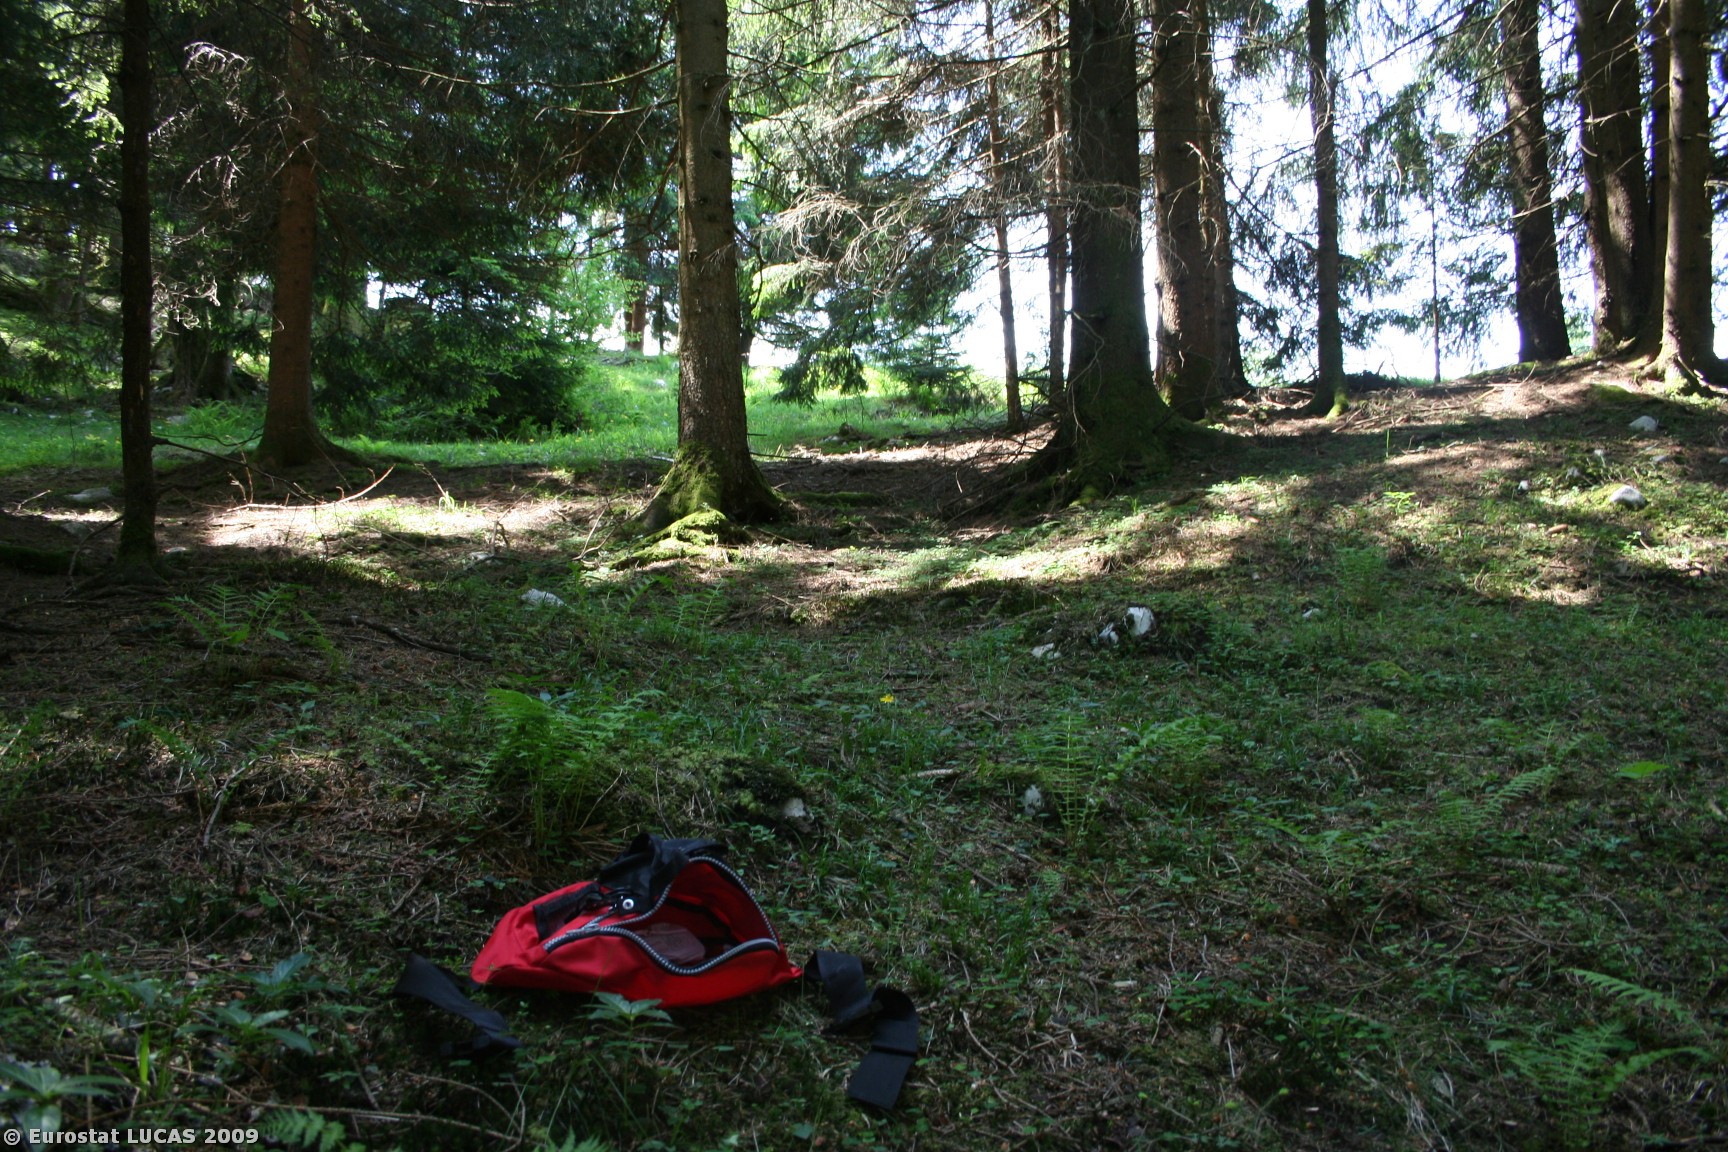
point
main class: Woodland
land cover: Coniferous woodland
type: alpine coniferous forest
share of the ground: > 75 %
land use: Forestry
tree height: > 5 m
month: May
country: AT
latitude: 47.6546
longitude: 13.2072
